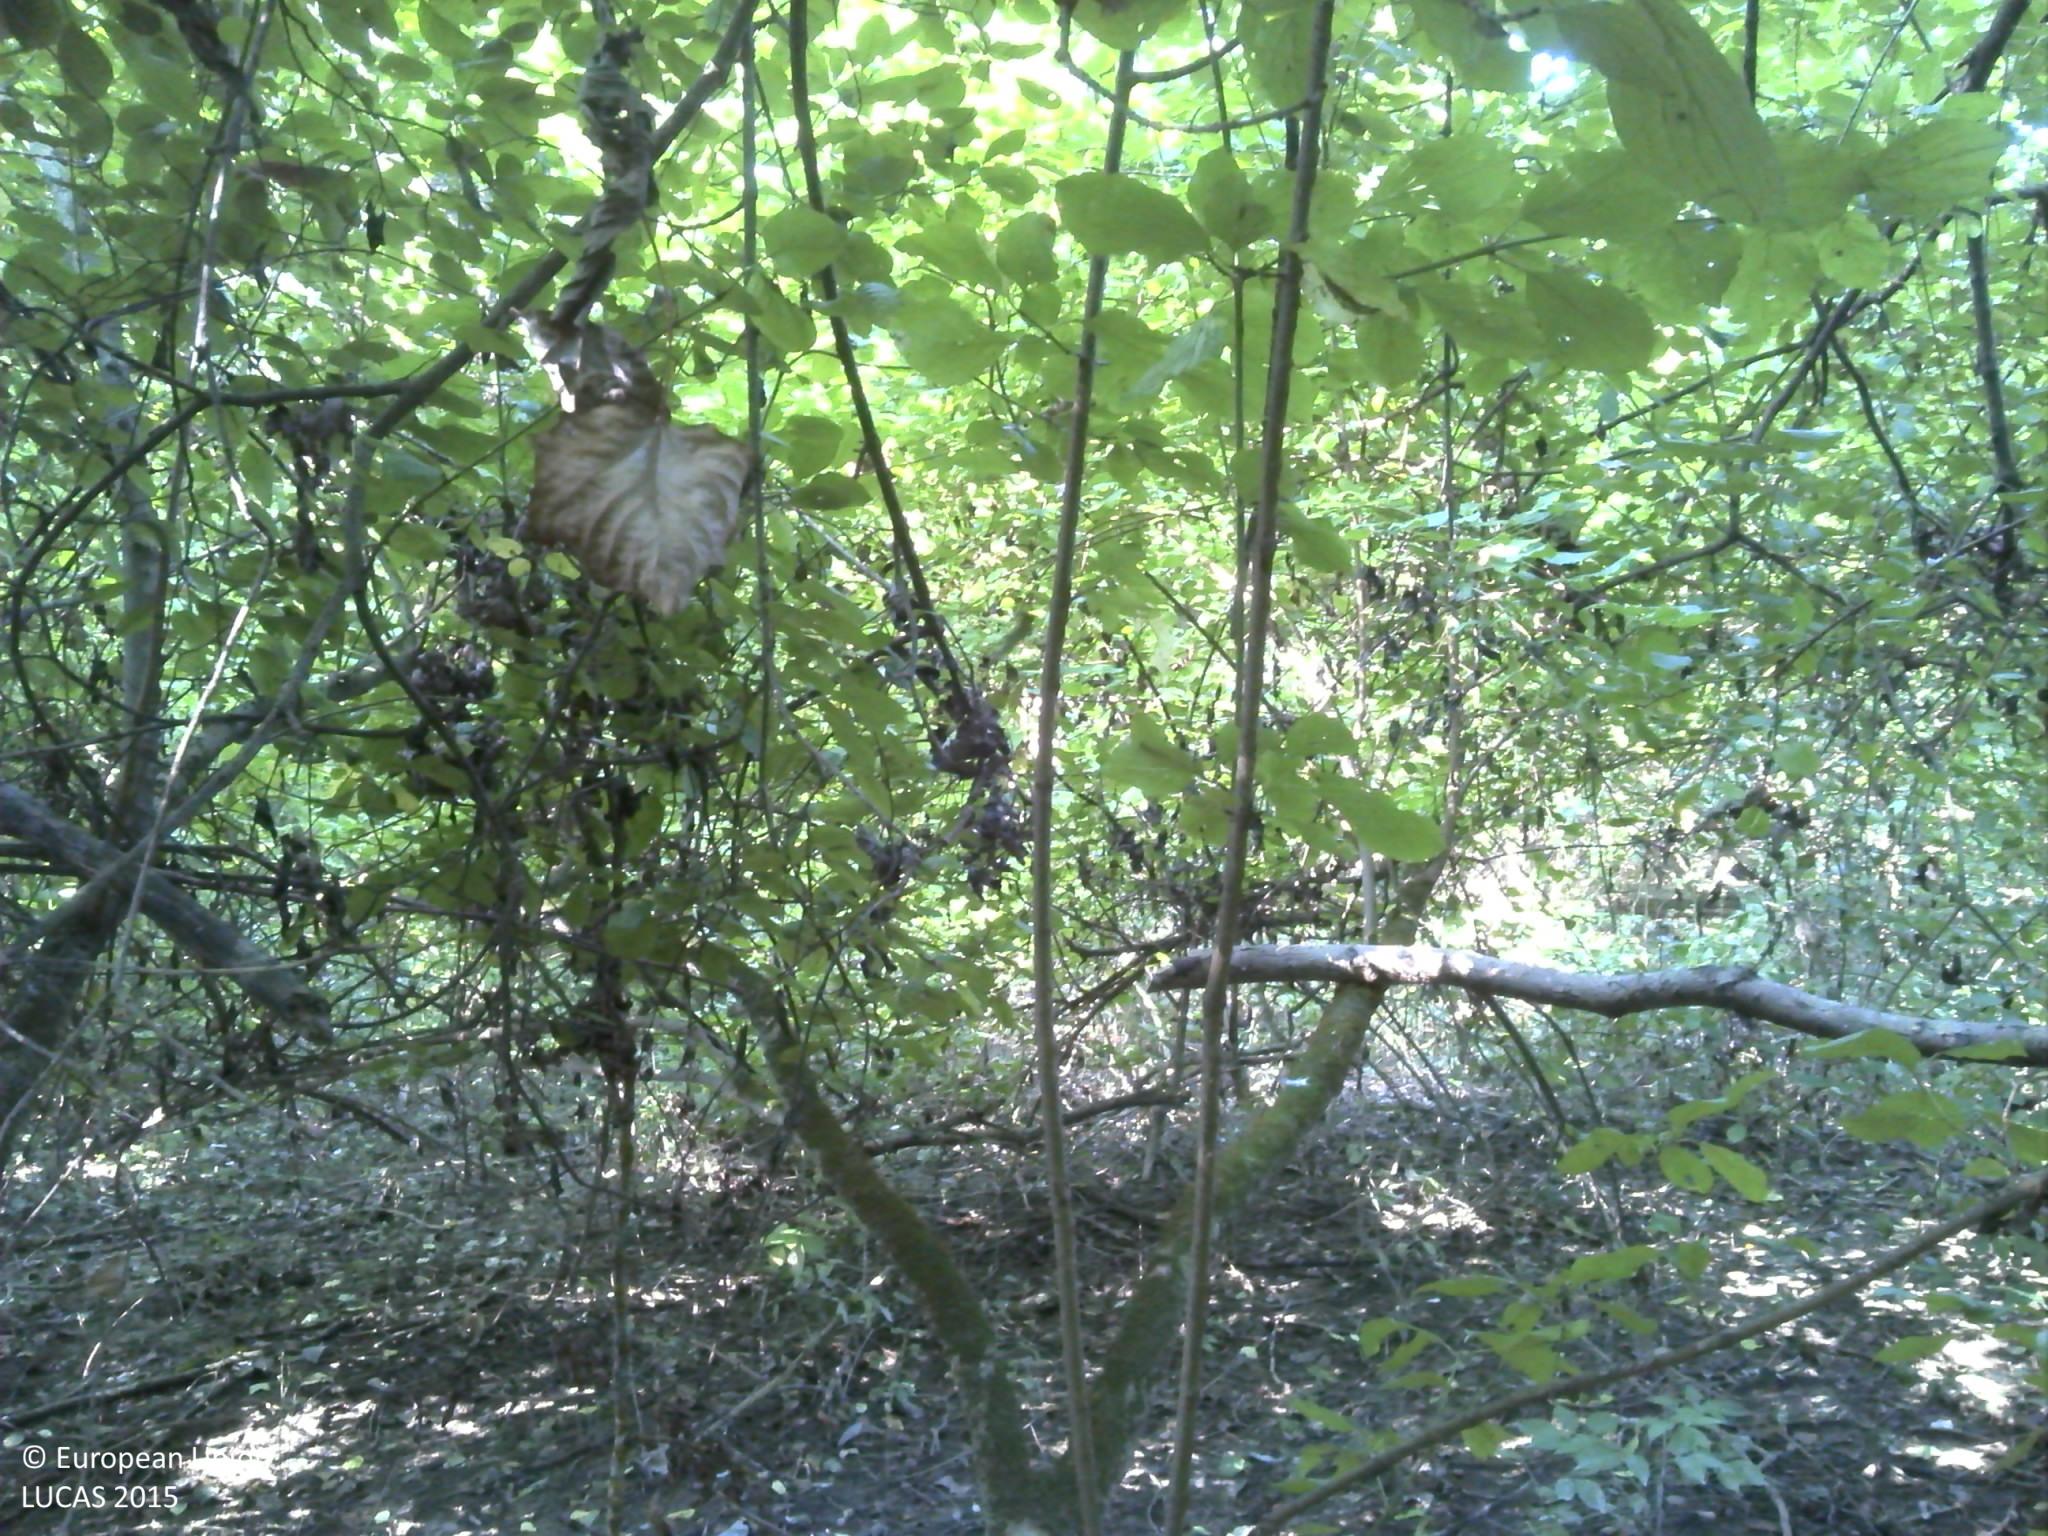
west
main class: Woodland
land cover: Broadleaved woodland
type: mesophytic deciduous forest
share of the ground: > 75 %
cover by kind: broadleaved forest trees 100 %
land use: Forestry
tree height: > 5 m
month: September
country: HR
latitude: 45.6206
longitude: 16.3466
